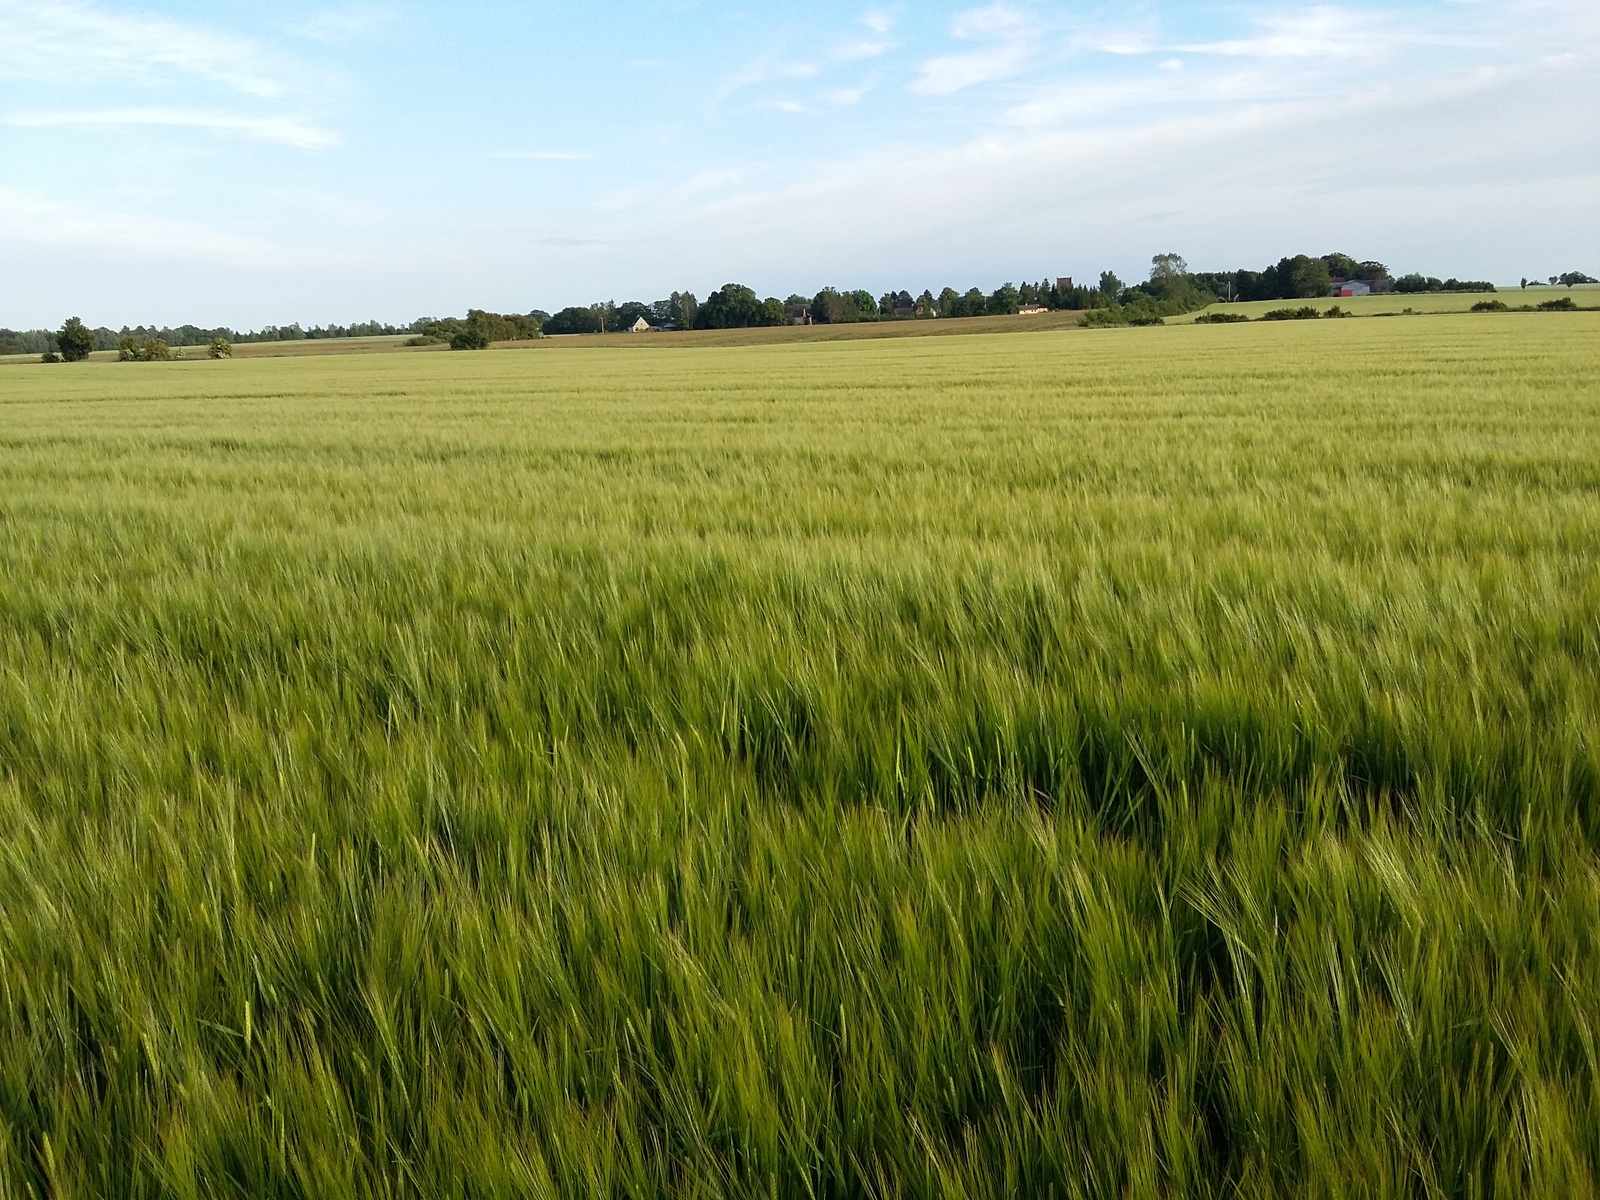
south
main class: Cropland
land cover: Barley
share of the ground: > 75 %
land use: Agriculture (excluding fallow land and kitchen gardens)
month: June
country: DK
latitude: 54.7697
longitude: 12.0039
